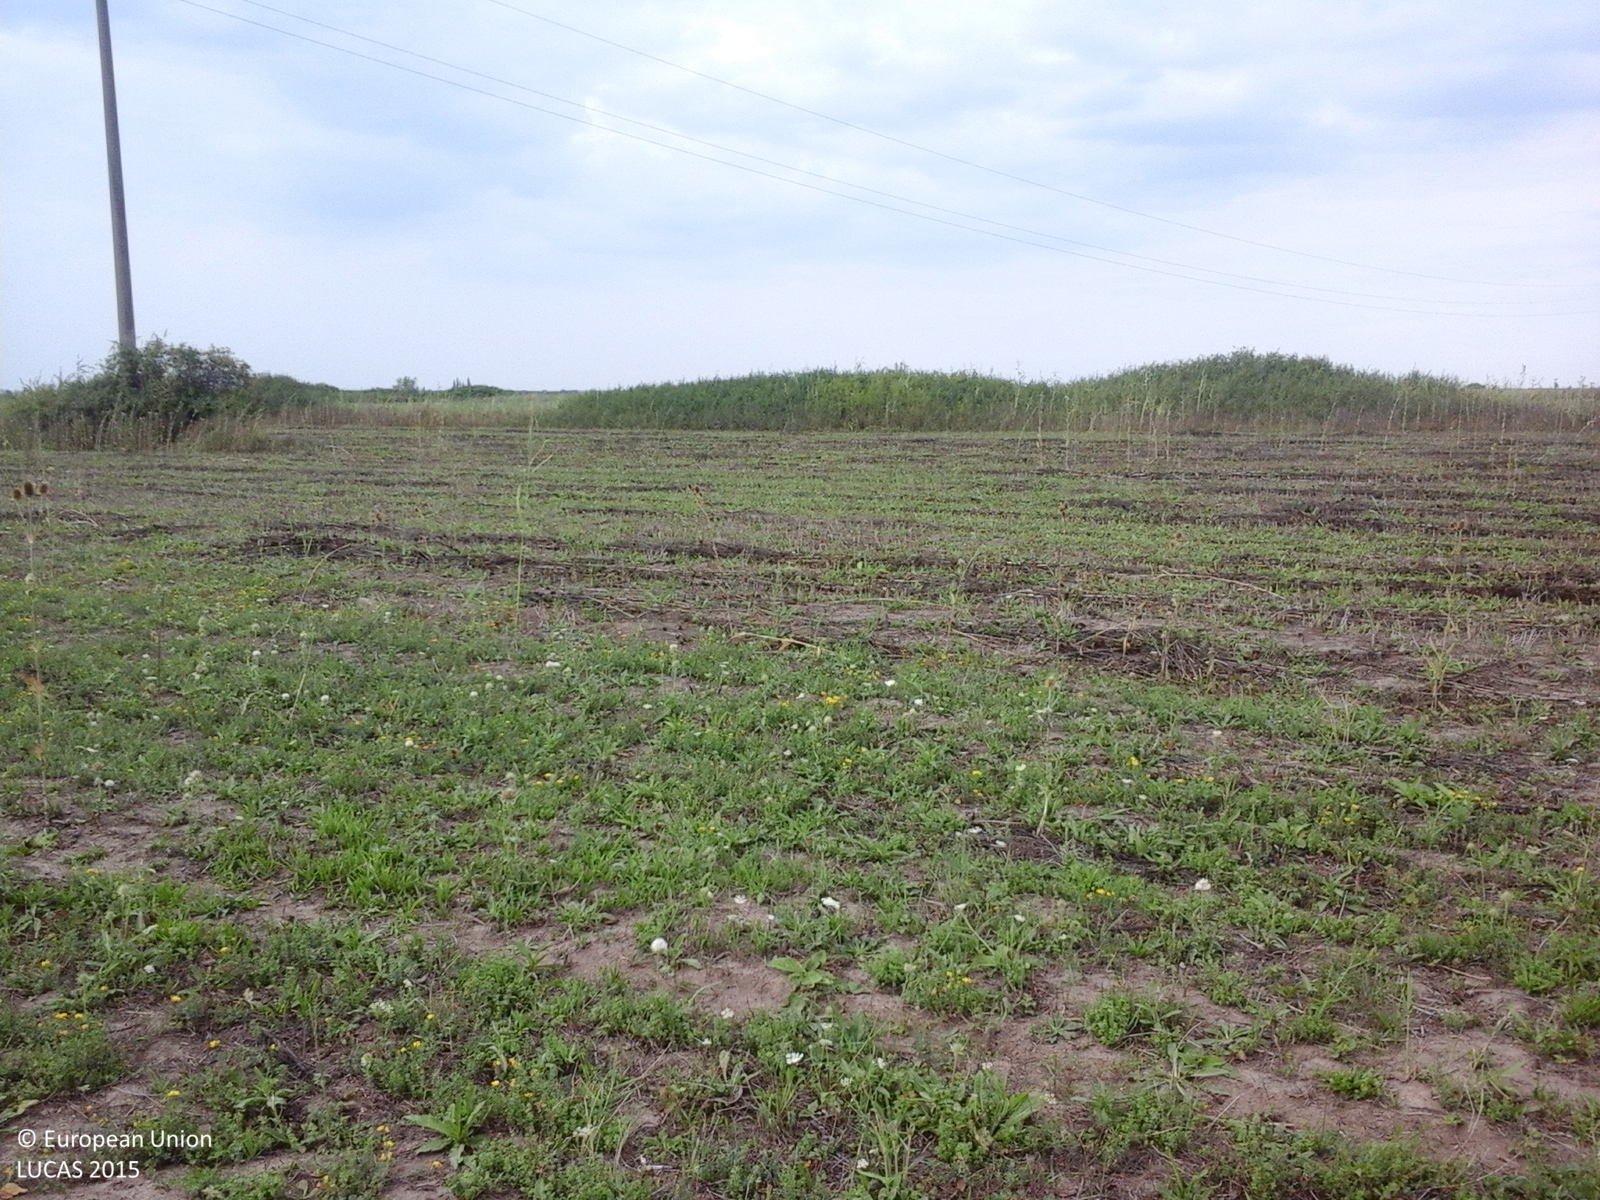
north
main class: Grassland
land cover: Spontaneously vegetated surfaces
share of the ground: > 75 %
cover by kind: herbaceous plants 100 %
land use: Fallow land
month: August
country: RO
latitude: 46.3908
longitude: 21.5993
